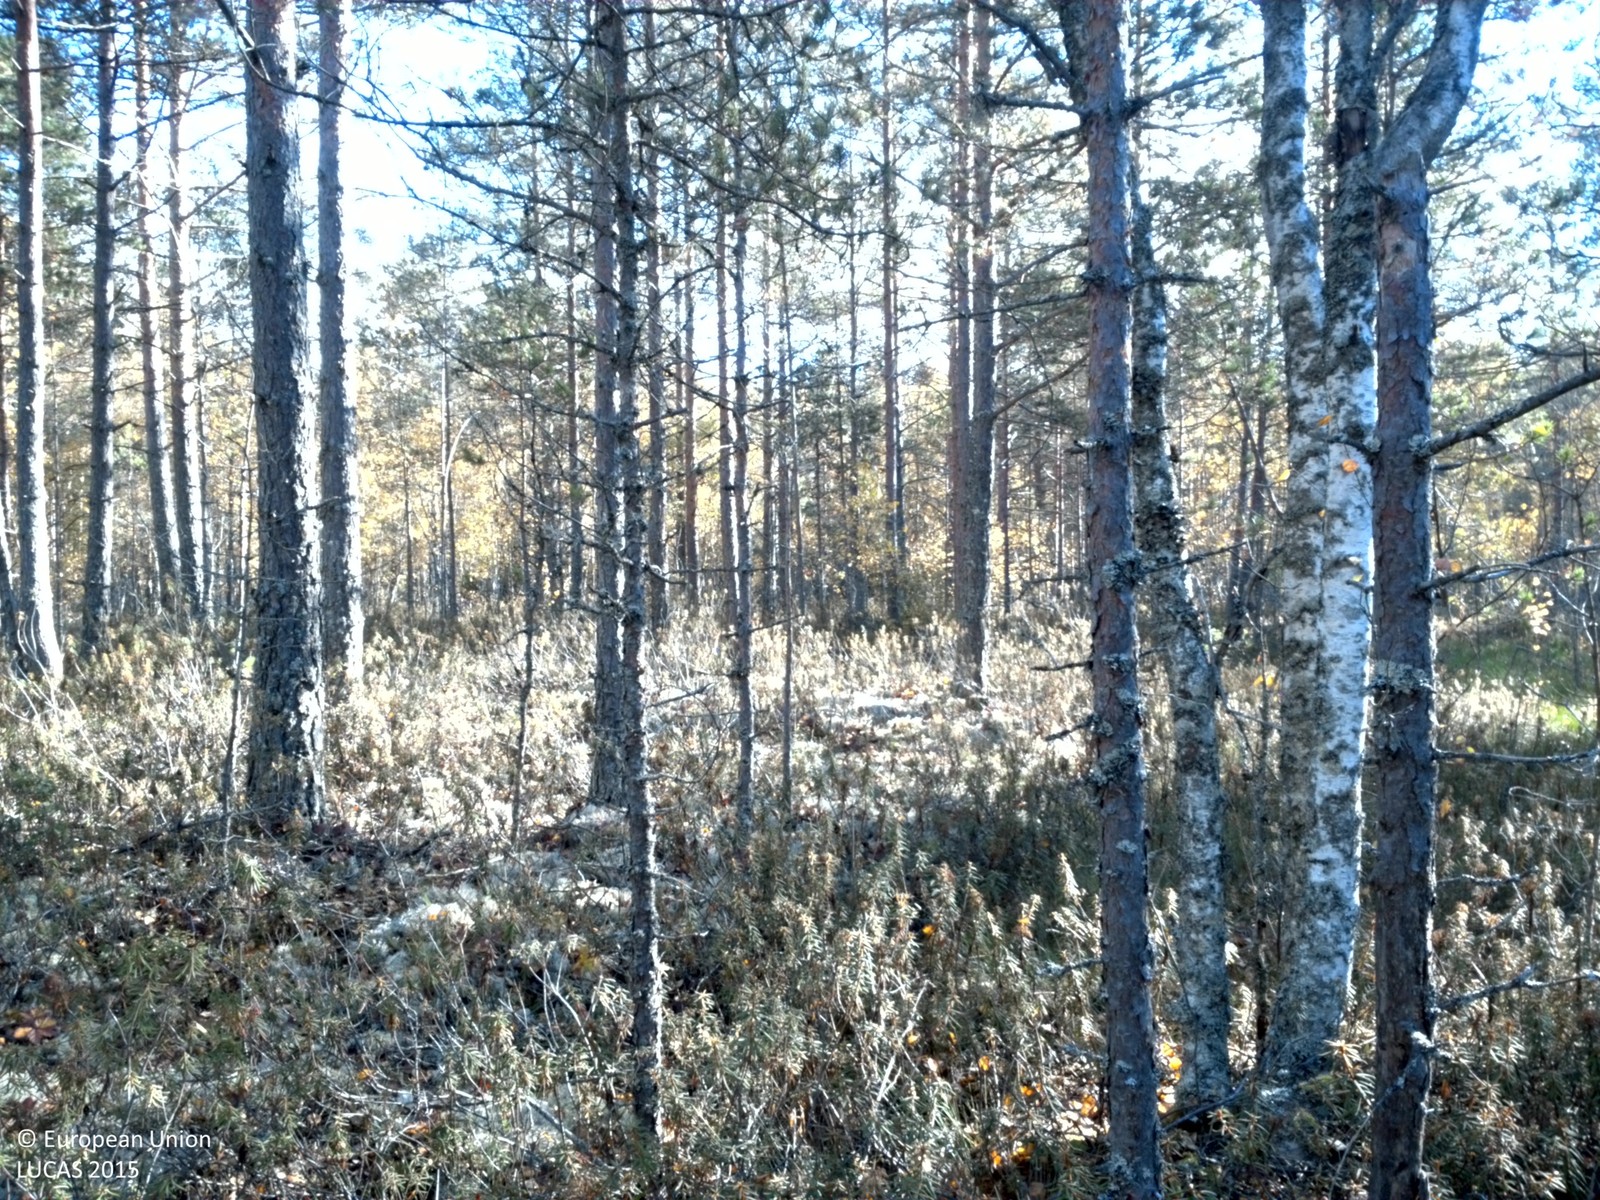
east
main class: Woodland
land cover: Pine dominated coniferous woodland
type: boreal forest
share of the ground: 50 - 75 %
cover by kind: coniferous forest trees 55 %, lichens and mosses 15 %, broadleaved forest trees 10 %, shrubs 10 %, herbaceous plants 10 %
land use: Forestry
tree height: > 5 m
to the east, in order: Pine dominated coniferous woodland; Other coniferous woodland; Spruce dominated coniferous woodland
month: September
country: SE
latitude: 59.9964
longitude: 16.4626
